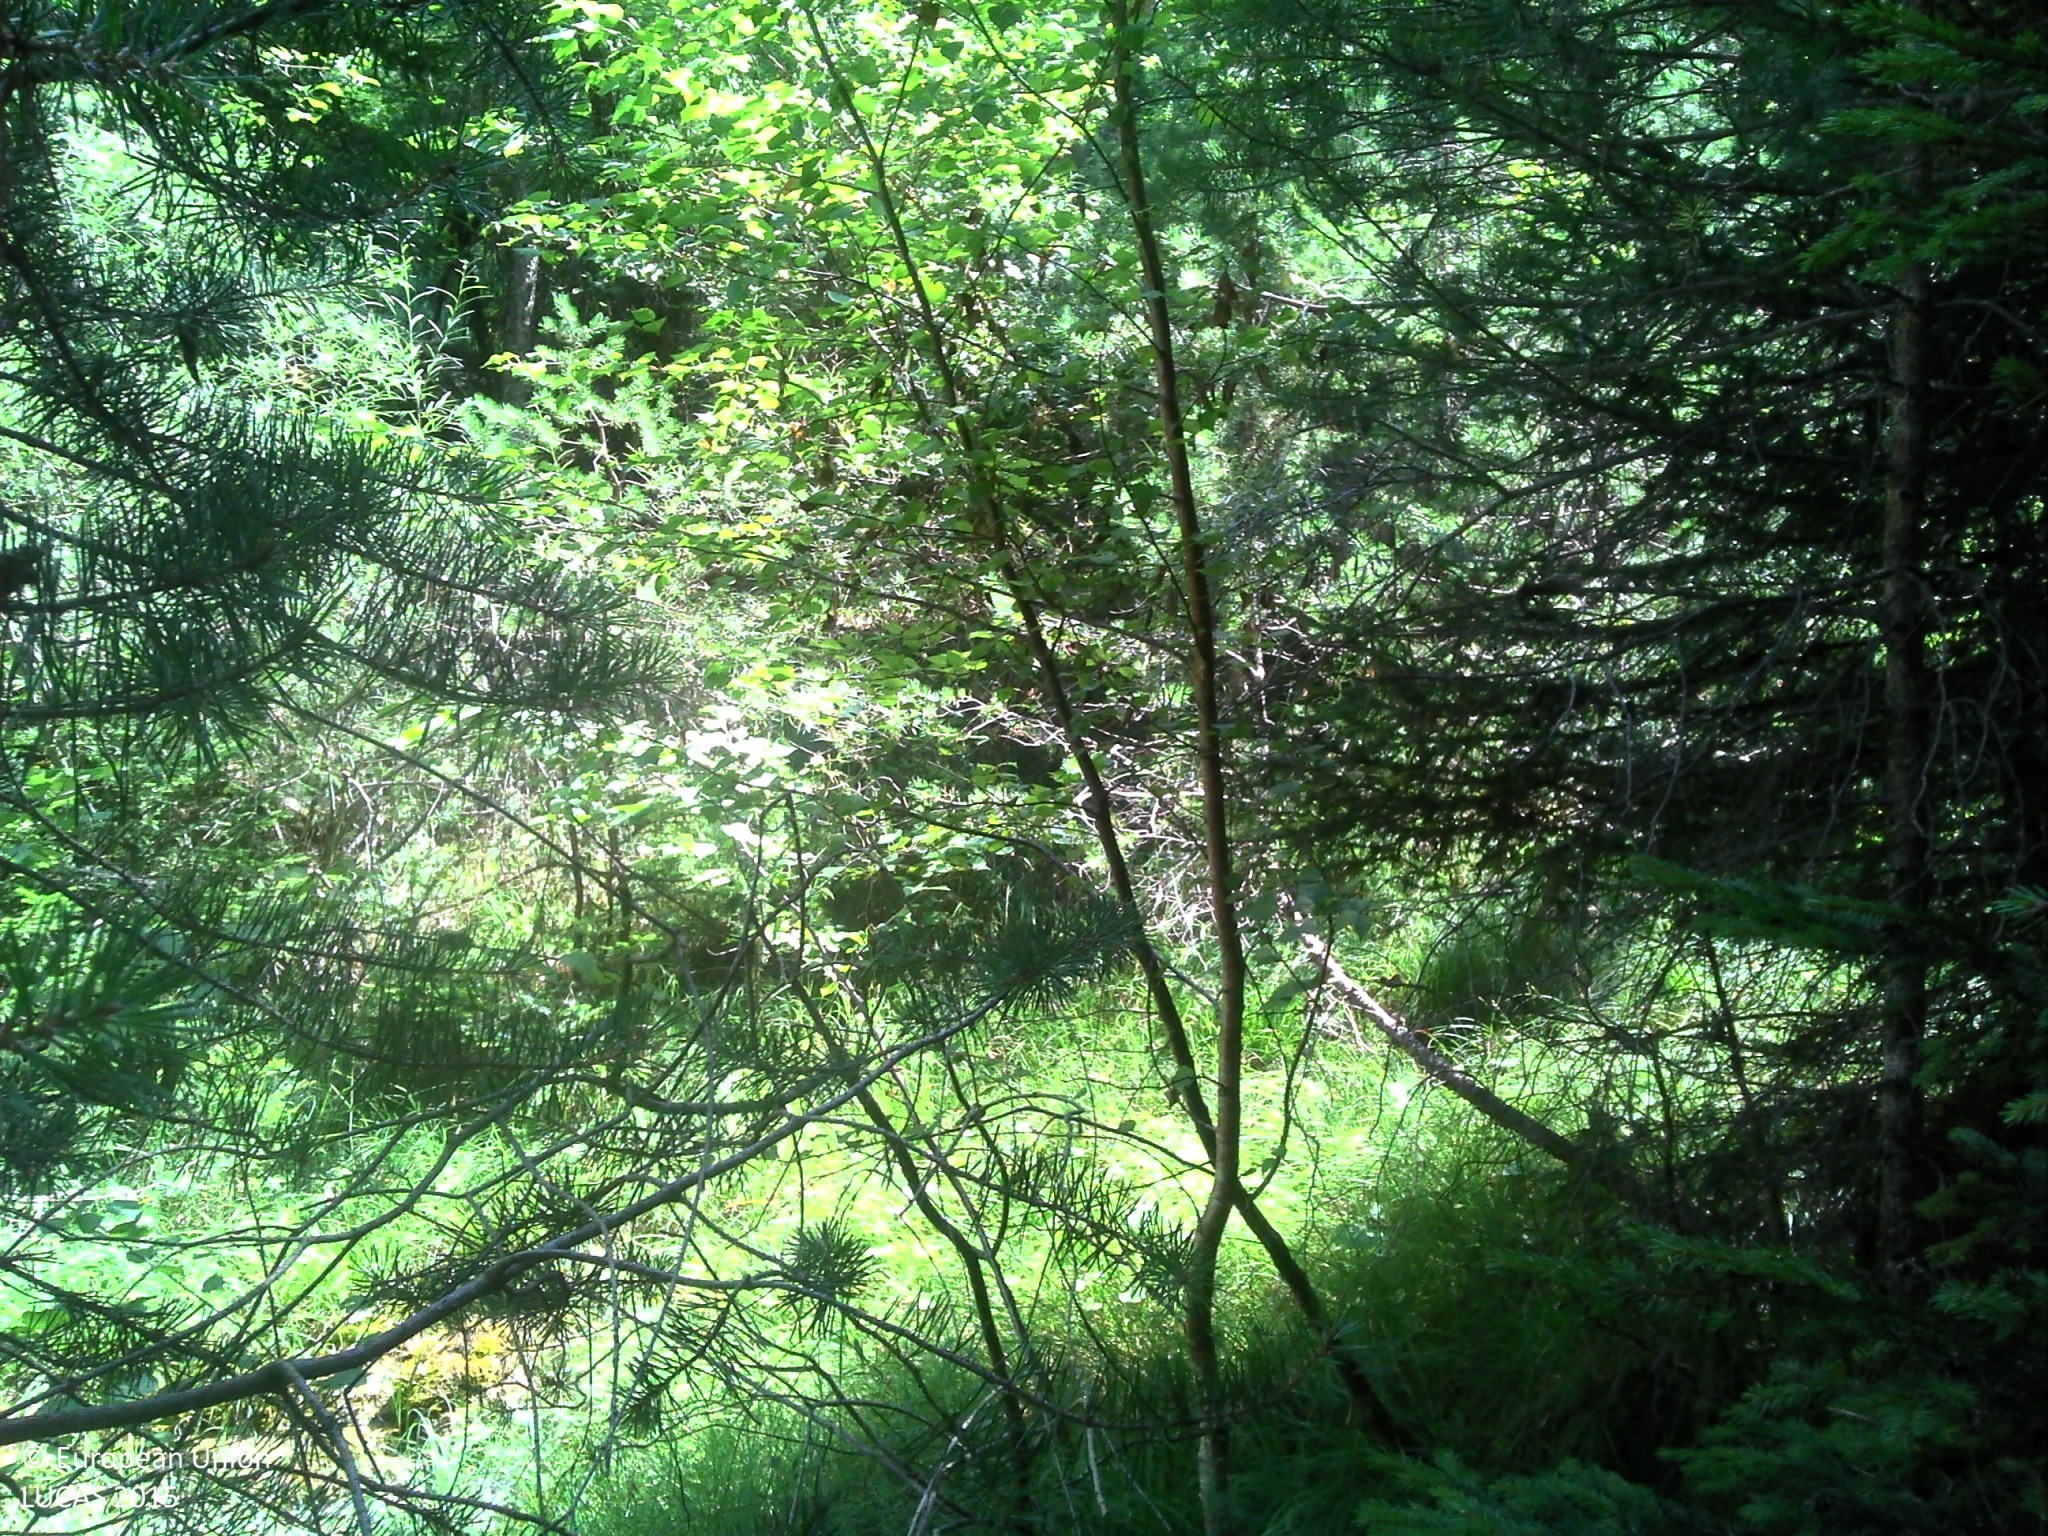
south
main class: Woodland
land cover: Pine dominated mixed woodland
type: alpine coniferous forest
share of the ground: > 75 %
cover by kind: coniferous forest trees 40 %, broadleaved forest trees 40 %, shrubs 10 %, herbaceous plants 10 %
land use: Forestry
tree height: > 5 m
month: August
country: FR
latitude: 44.3845
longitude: 6.5798
